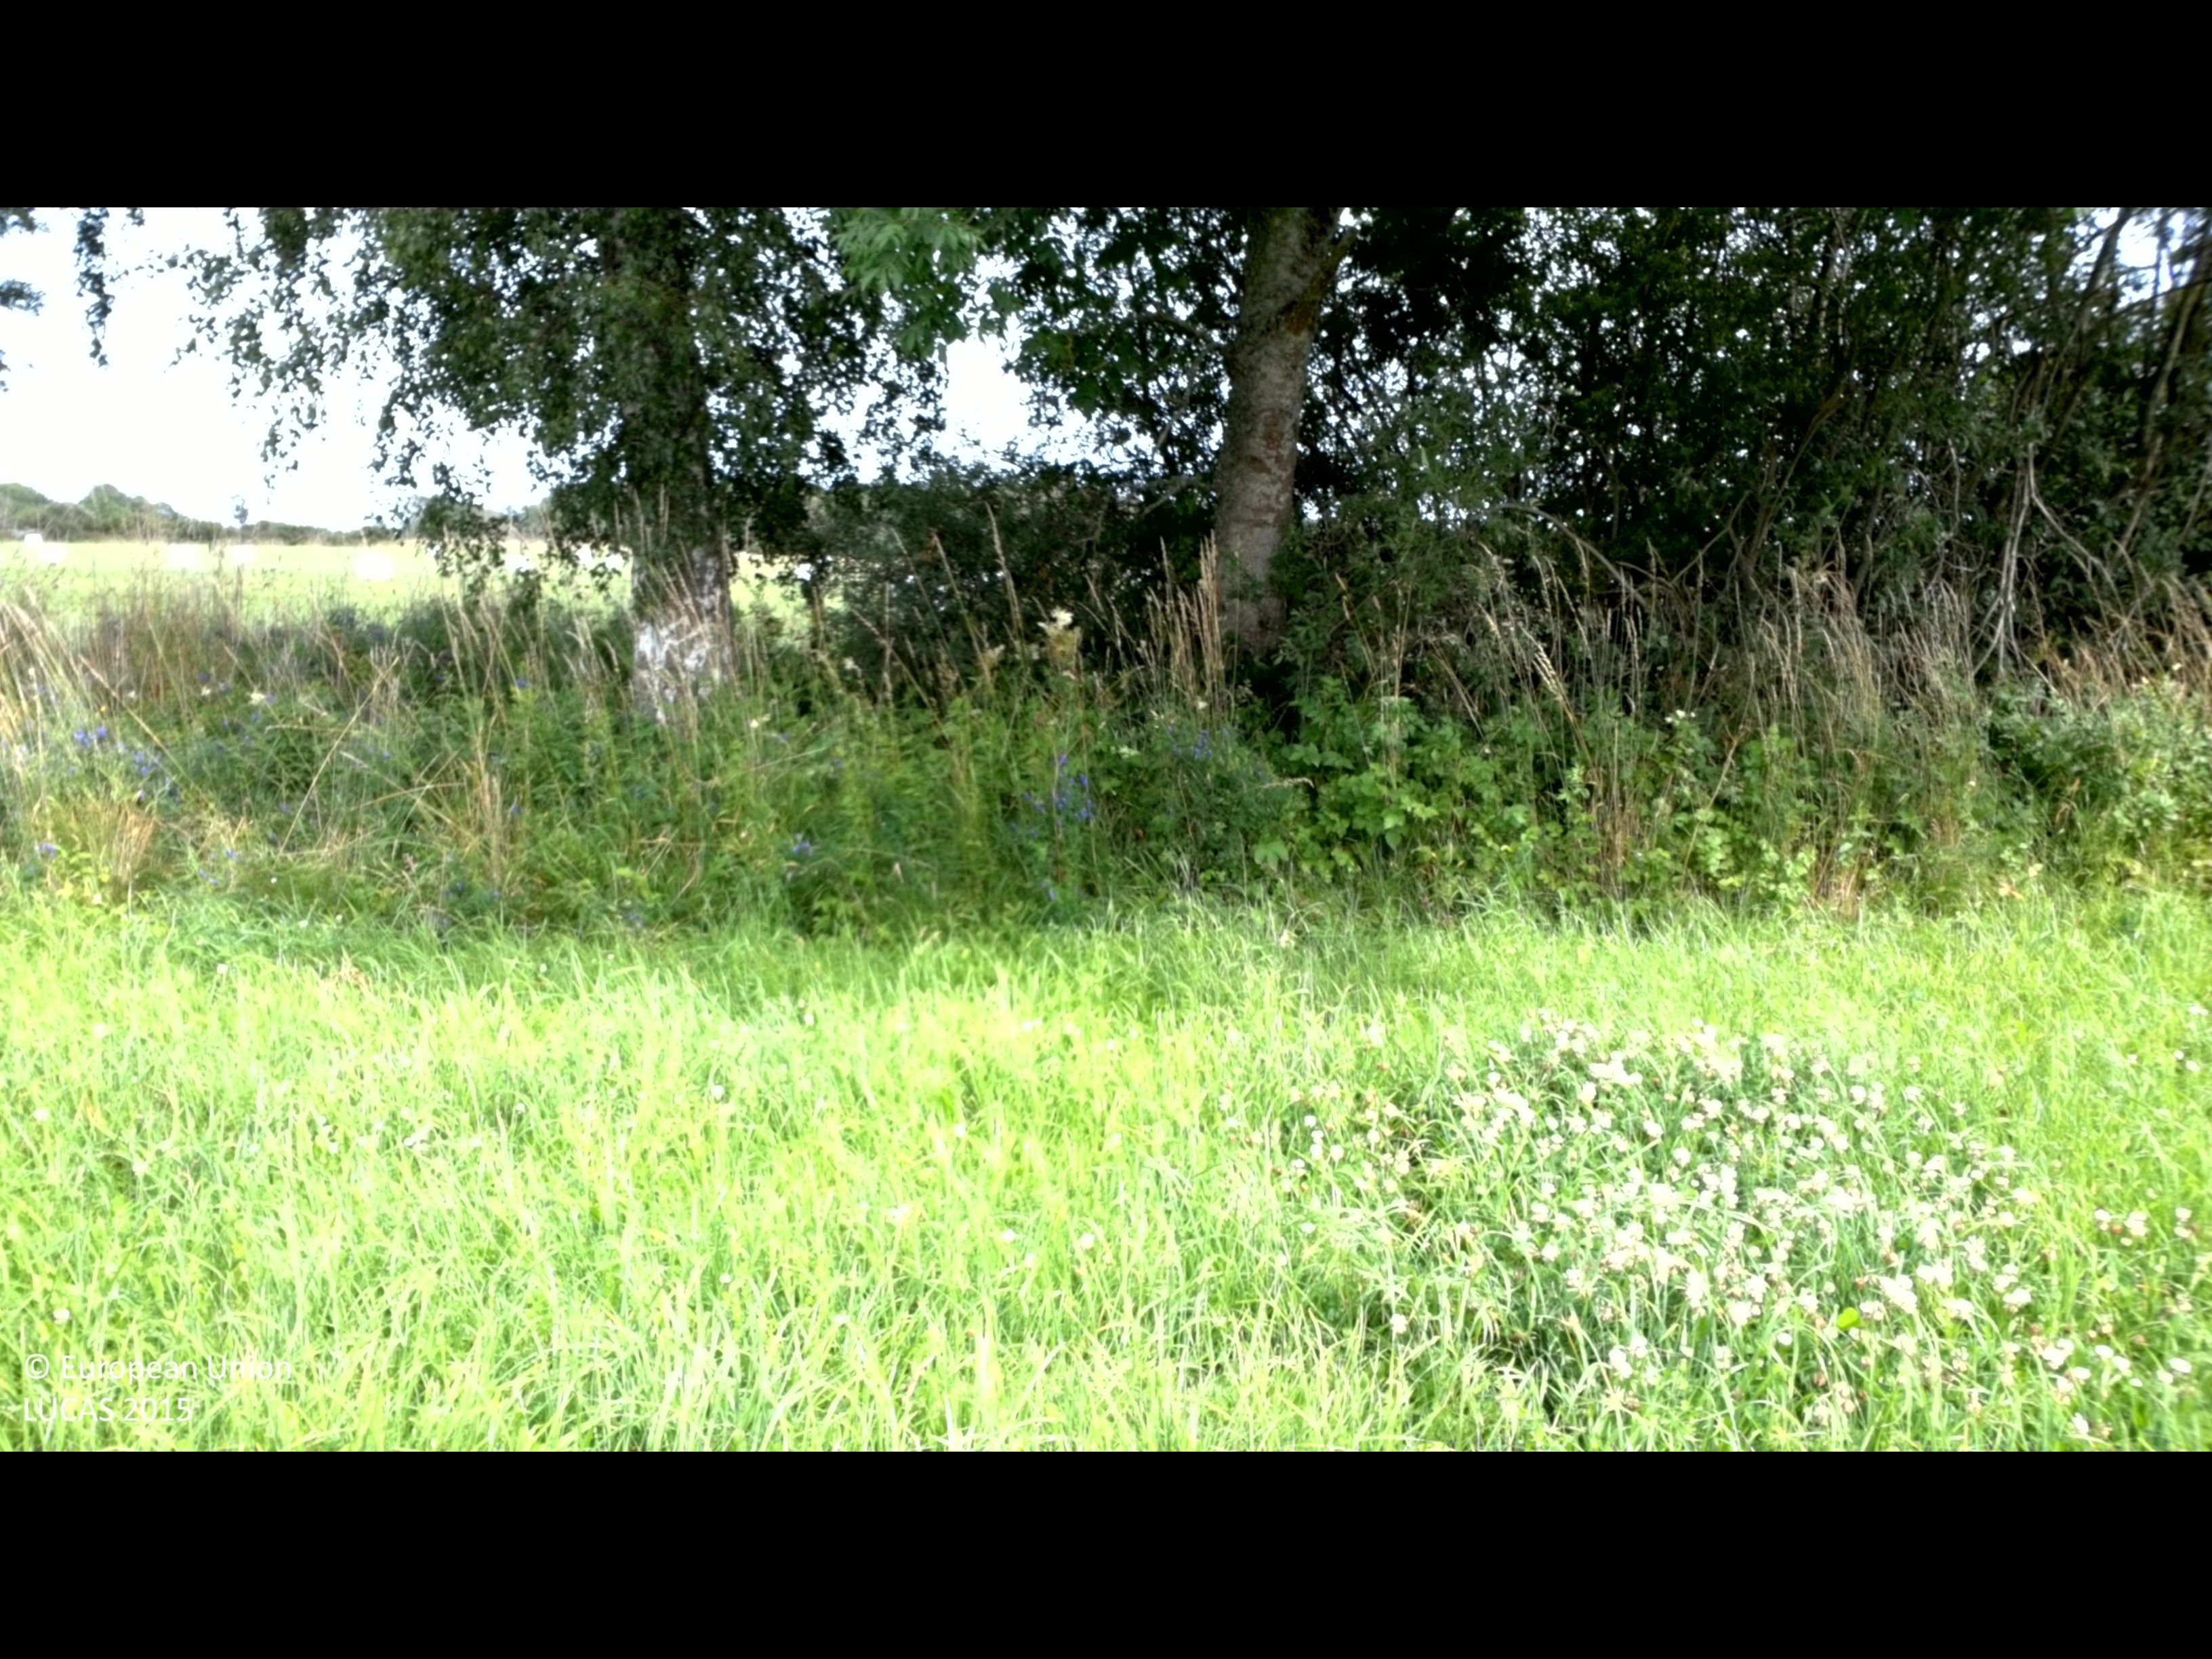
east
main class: Grassland
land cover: Grassland without tree/shrub cover
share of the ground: > 75 %
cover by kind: herbaceous plants 100 %
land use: Agriculture (excluding fallow land and kitchen gardens)
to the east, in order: Grassland without tree/shrub cover; Lines of trees; Temporary grasslands
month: July
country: SE
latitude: 57.0486
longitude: 16.9088
